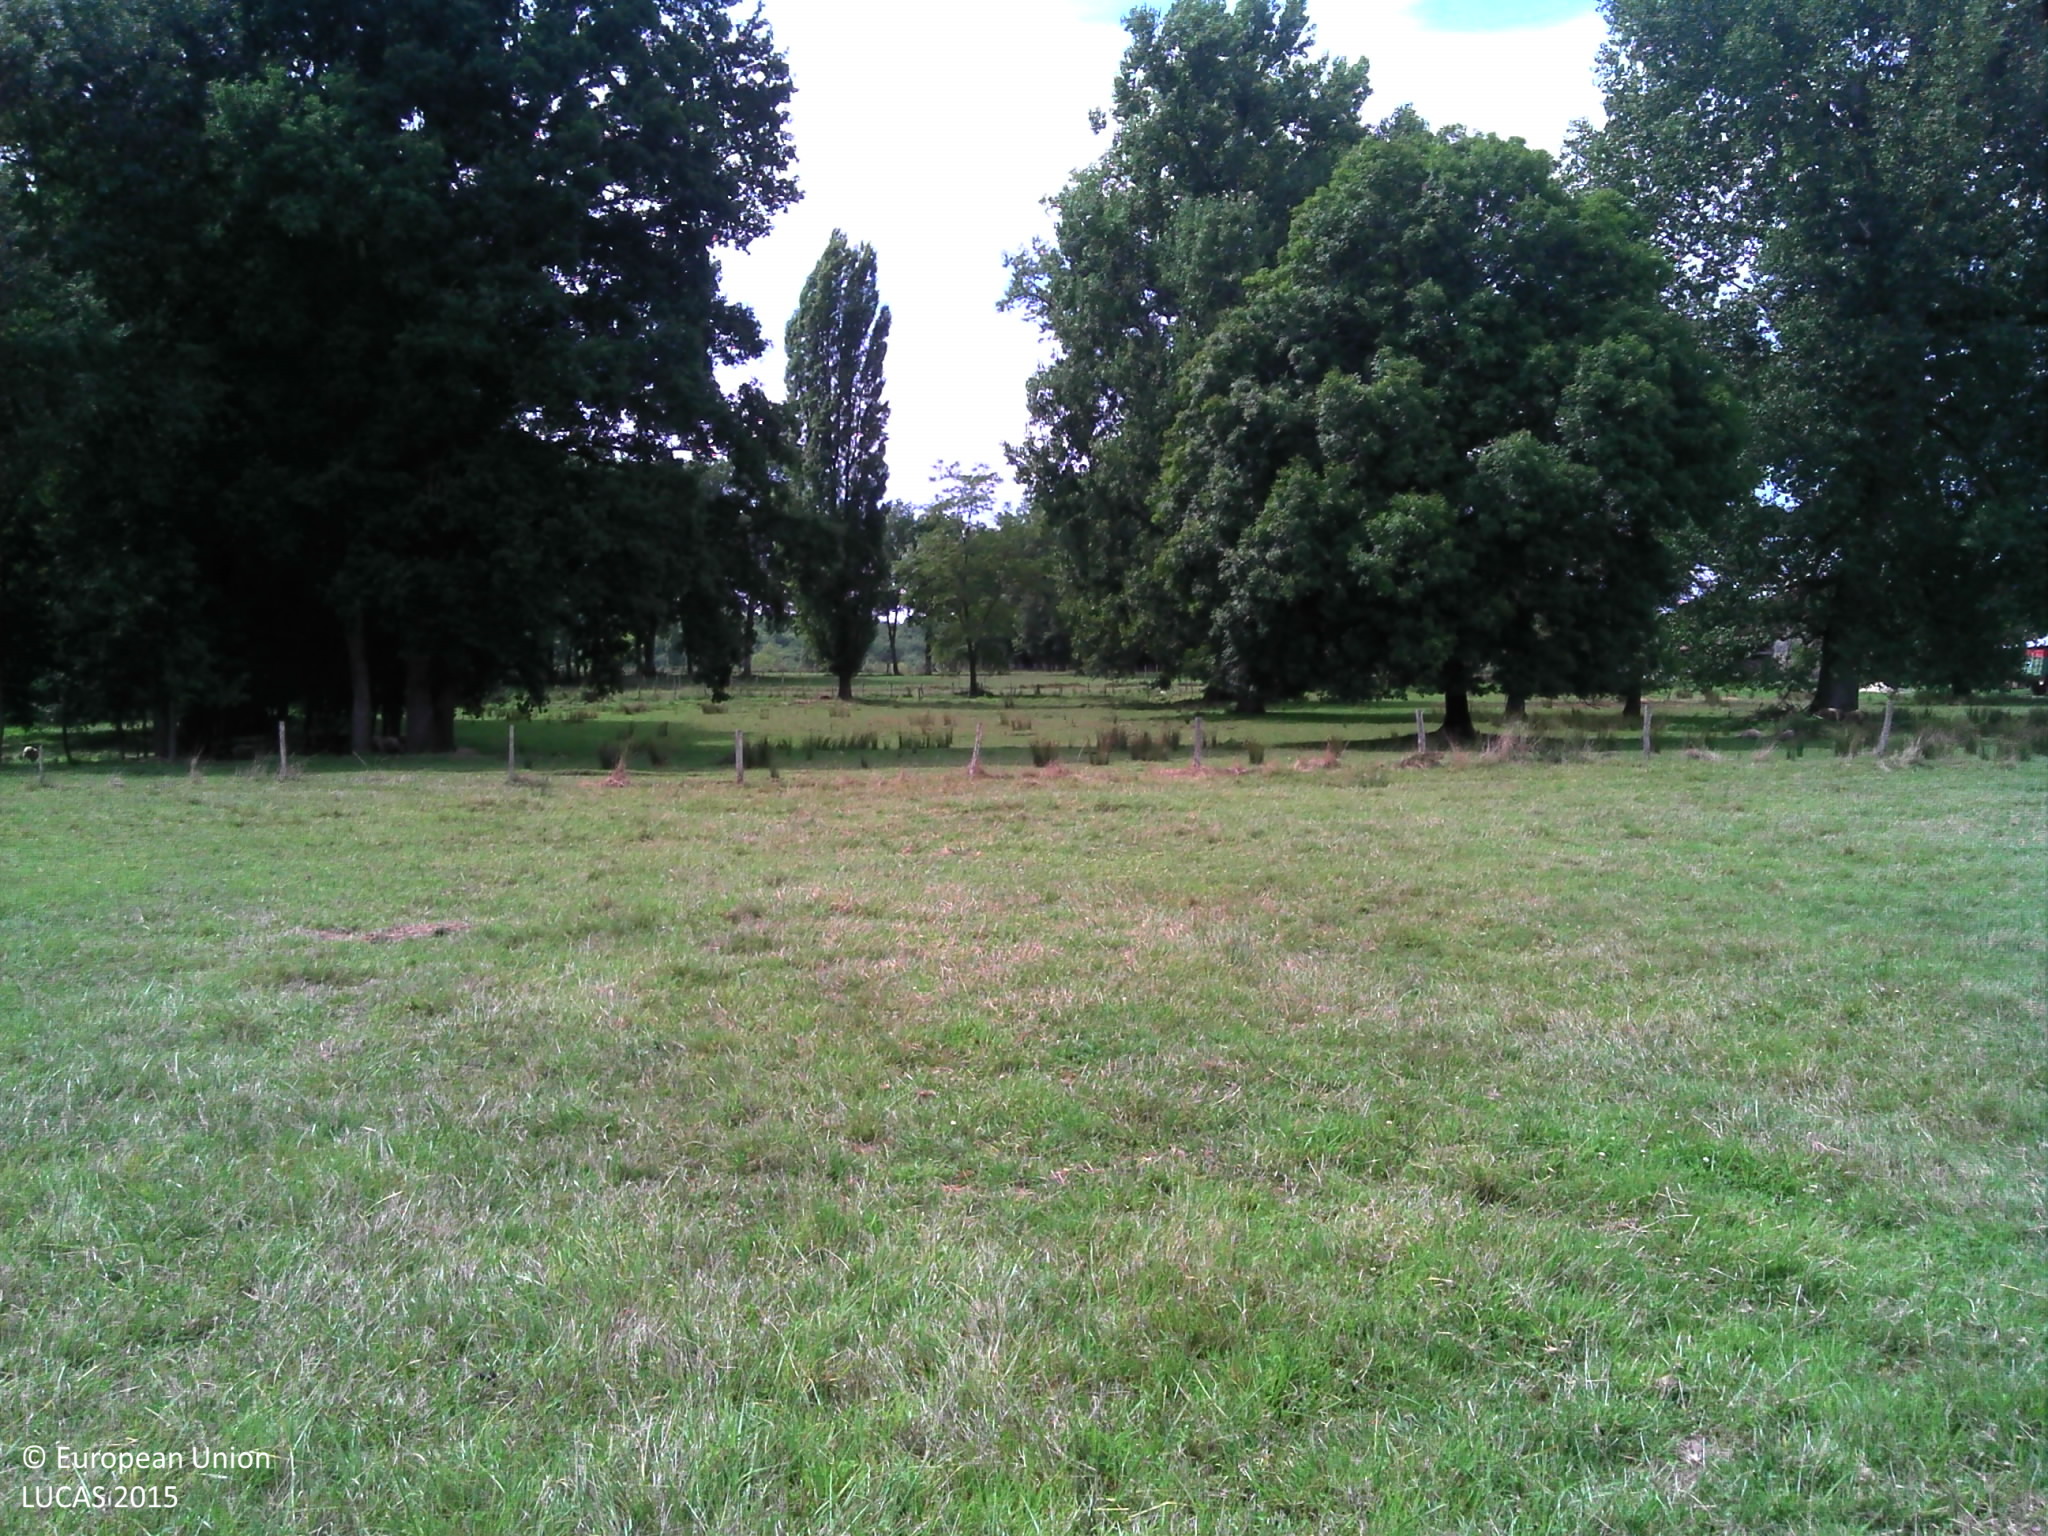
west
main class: Grassland
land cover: Grassland without tree/shrub cover
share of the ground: > 75 %
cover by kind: herbaceous plants 90 %, lichens and mosses 10 %
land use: Agriculture (excluding fallow land and kitchen gardens)
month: August
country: FR
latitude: 45.3476
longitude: 0.5047
